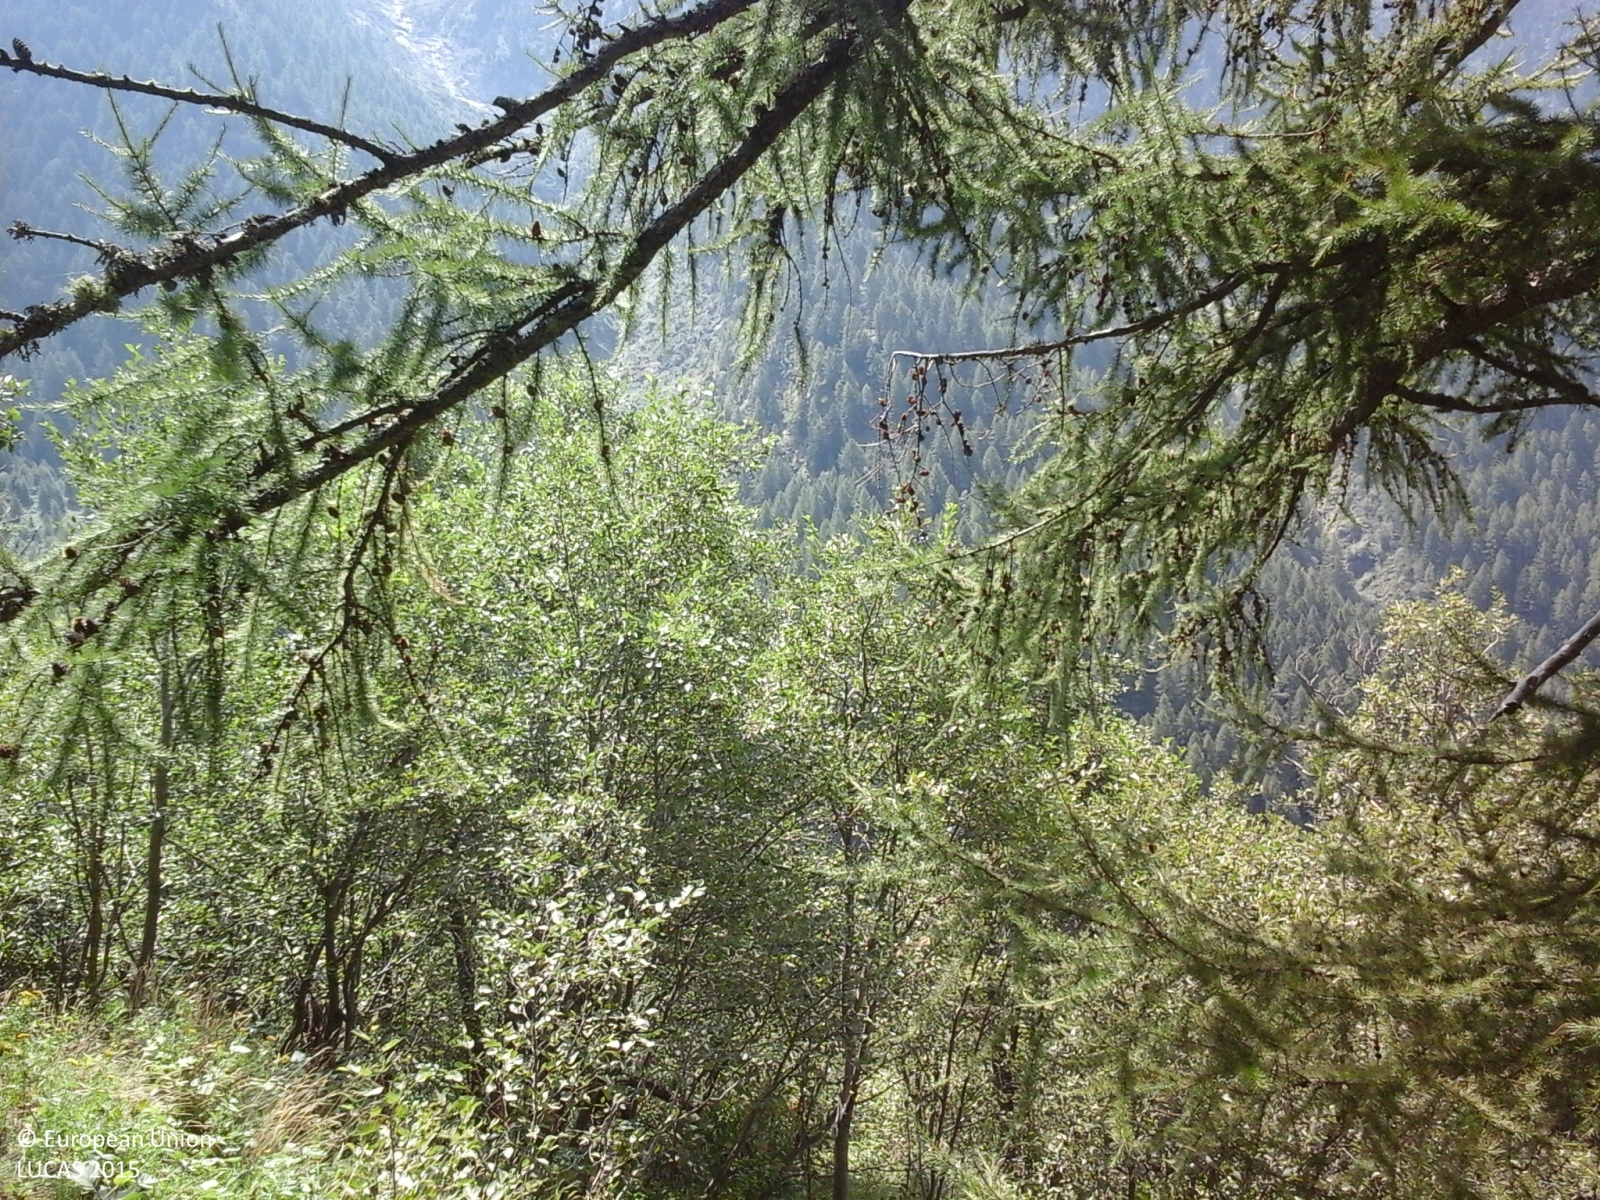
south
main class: Woodland
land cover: Other mixed woodland
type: mesophytic deciduous forest
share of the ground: > 75 %
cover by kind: broadleaved forest trees 75 %, coniferous forest trees 25 %
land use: Semi-natural and natural areas not in use
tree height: > 5 m
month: August
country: IT
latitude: 45.6789
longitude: 7.7566
